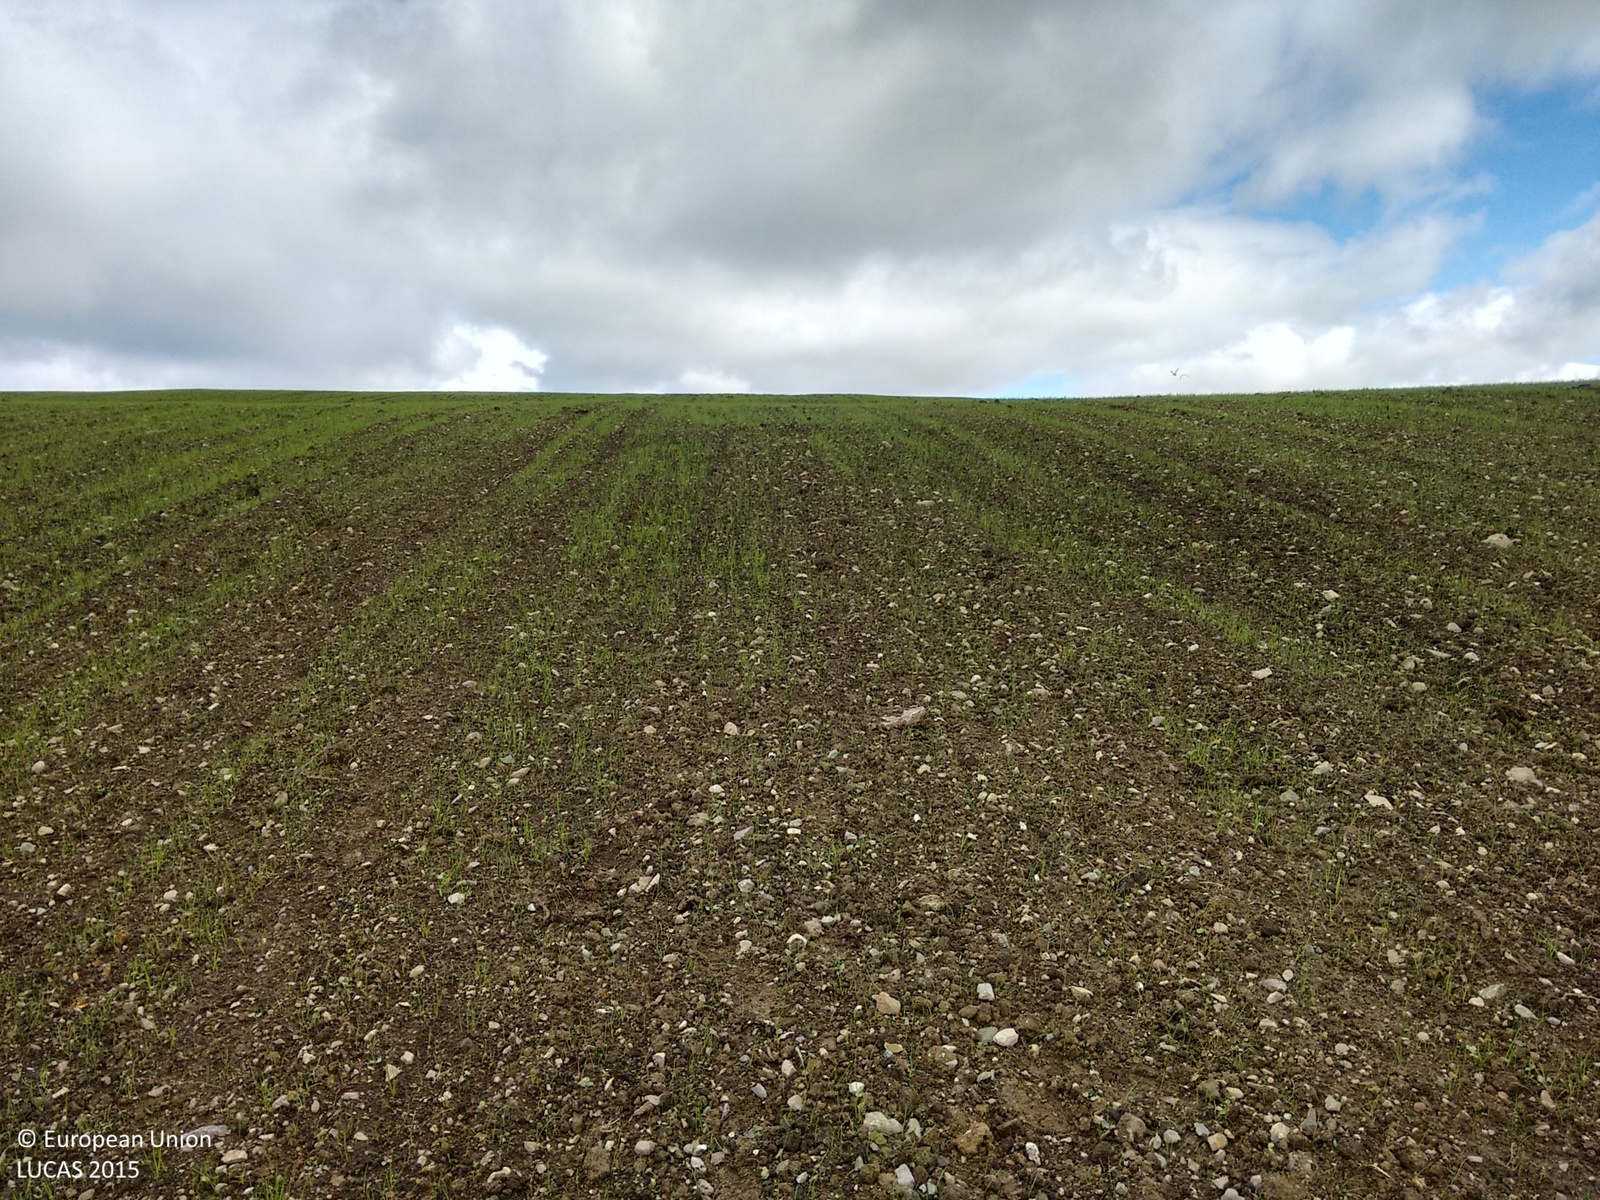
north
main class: Grassland
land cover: Grassland without tree/shrub cover
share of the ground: 10 - 25 %
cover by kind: unconsolidated bare surface 80 %, herbaceous plants 10 %
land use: Agriculture (excluding fallow land and kitchen gardens)
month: July
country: GB
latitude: 56.6485
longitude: -3.2308
